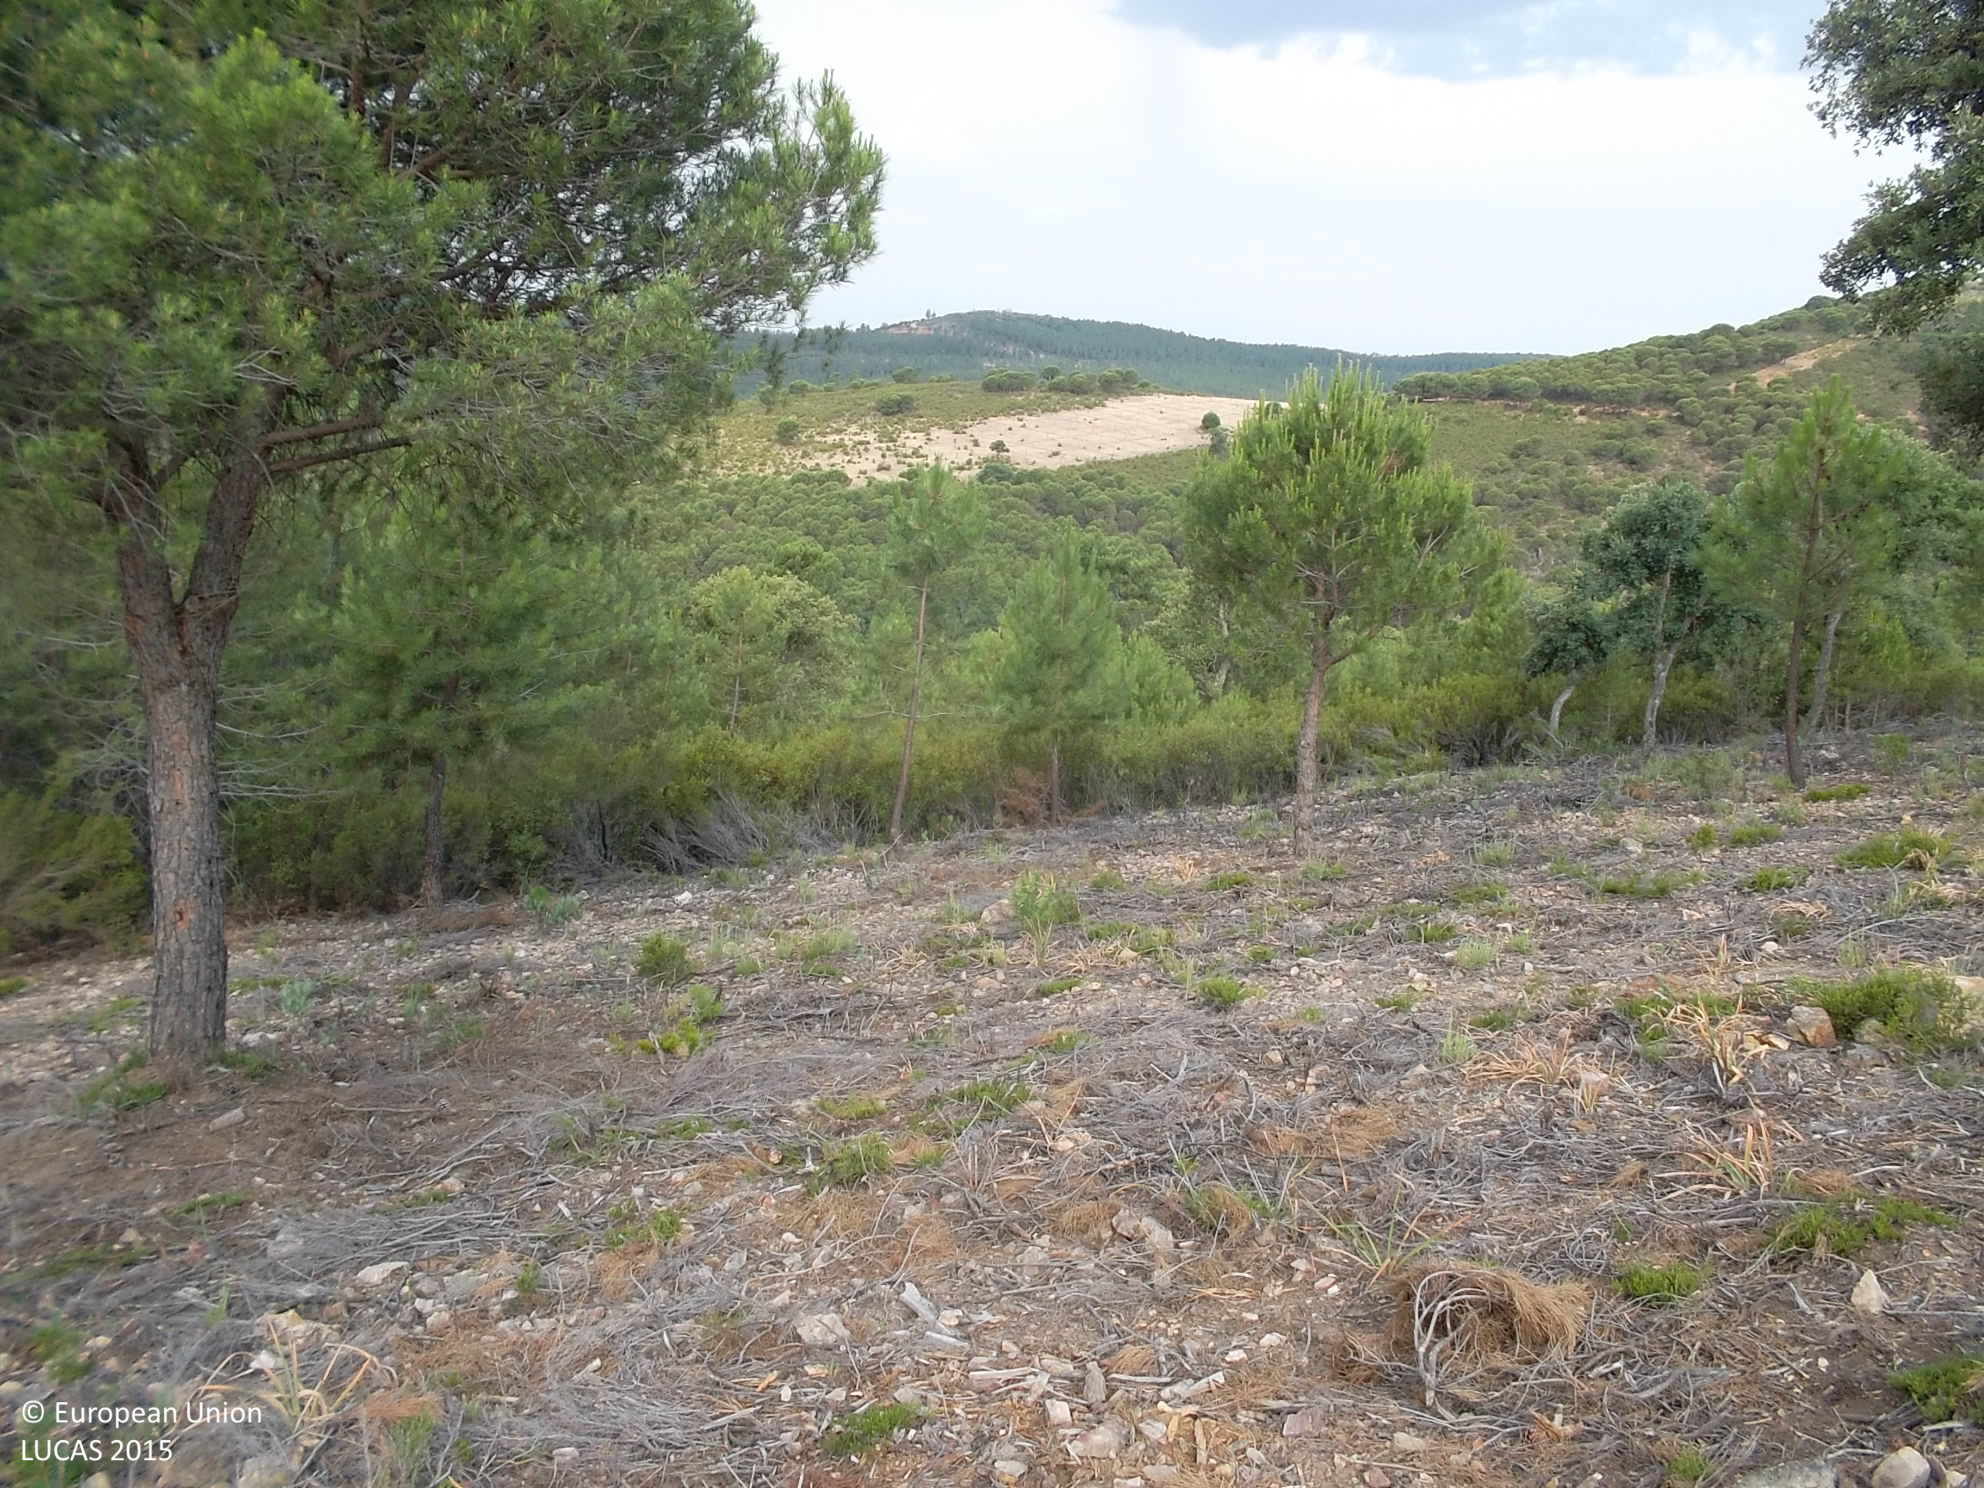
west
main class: Woodland
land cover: Pine dominated coniferous woodland
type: coniferous forest of the mediterranean region
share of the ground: 50 - 75 %
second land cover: Spontaneously vegetated surfaces
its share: > 75 %
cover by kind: coniferous forest trees 40 %, herbaceous plants 40 %, unconsolidated bare surface 20 %
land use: Forestry
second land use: Agriculture (excluding fallow land and kitchen gardens)
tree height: > 5 m
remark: Clear cut
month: June
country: ES
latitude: 39.1828
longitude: -4.8660
